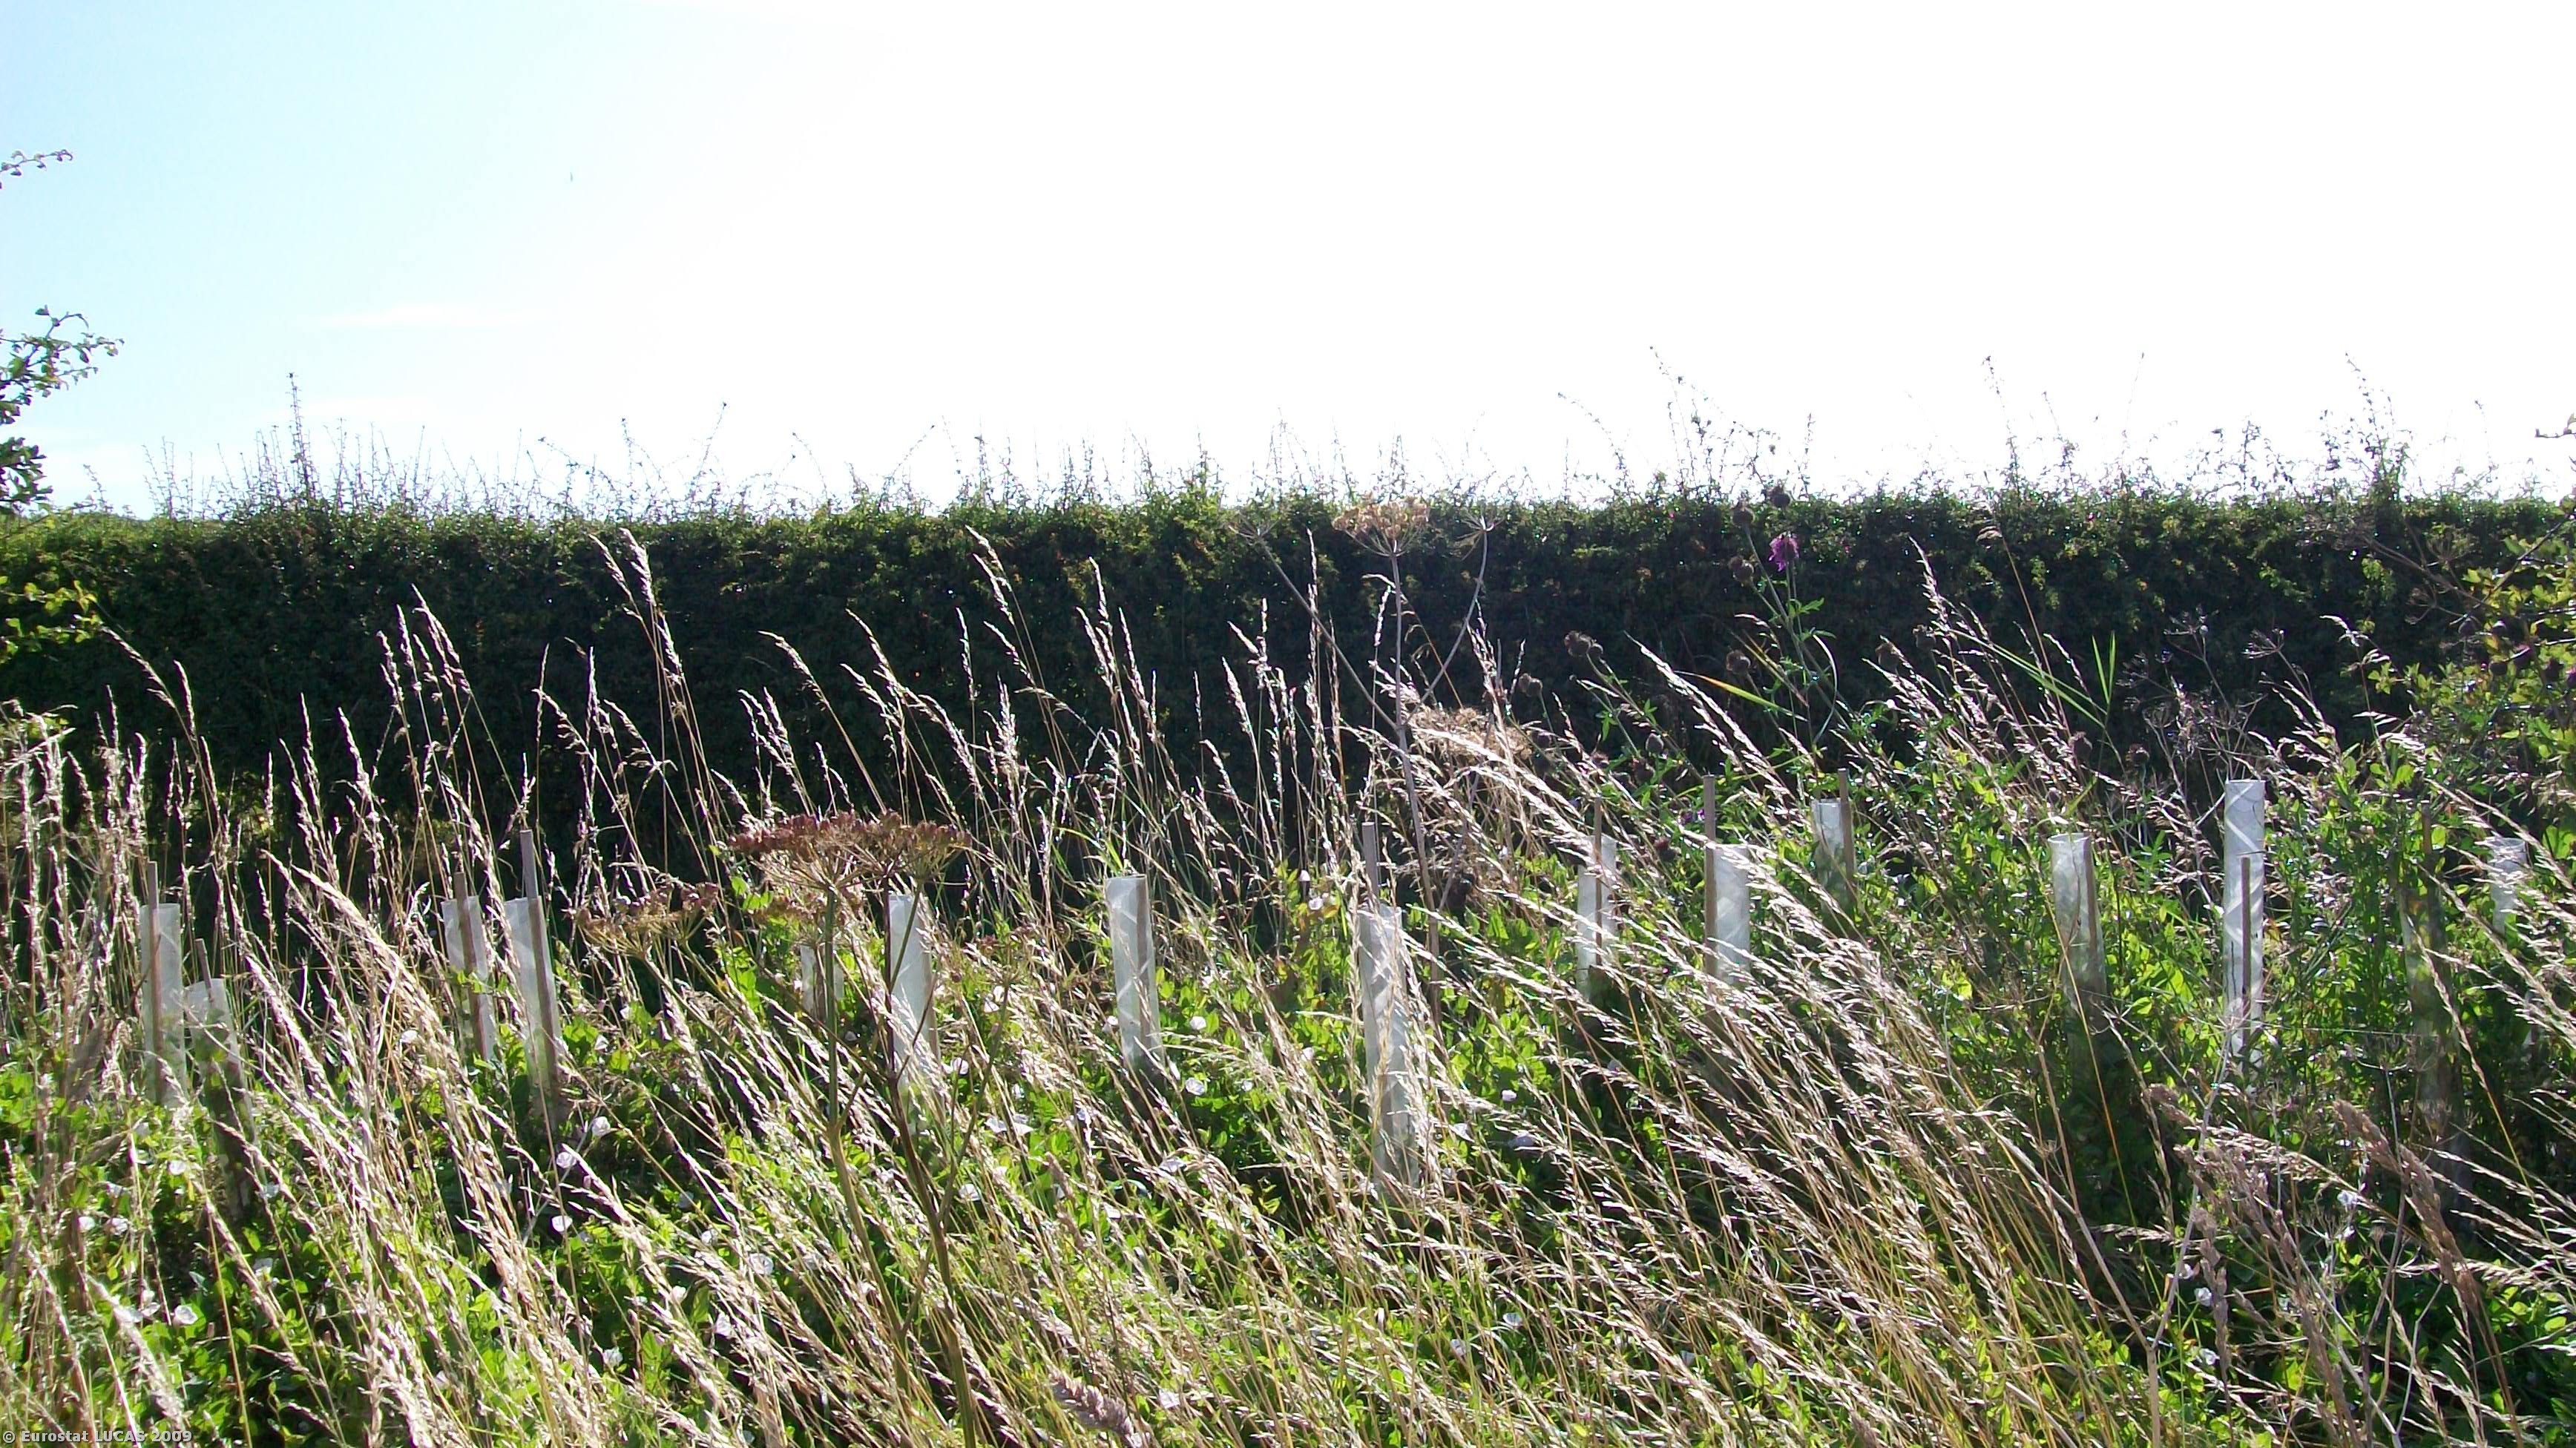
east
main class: Grassland
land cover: Grassland without tree/shrub cover
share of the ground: > 75 %
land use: Agriculture (excluding fallow land and kitchen gardens)
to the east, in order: Grassland without tree/shrub cover; Managed hedges; Grass margins; Paved roads, cycling and walking lanes; Grass margins; Managed hedges; Grassland without tree/shrub cover; Rape and turnip rape
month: July
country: GB
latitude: 54.0761
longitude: -0.4129
